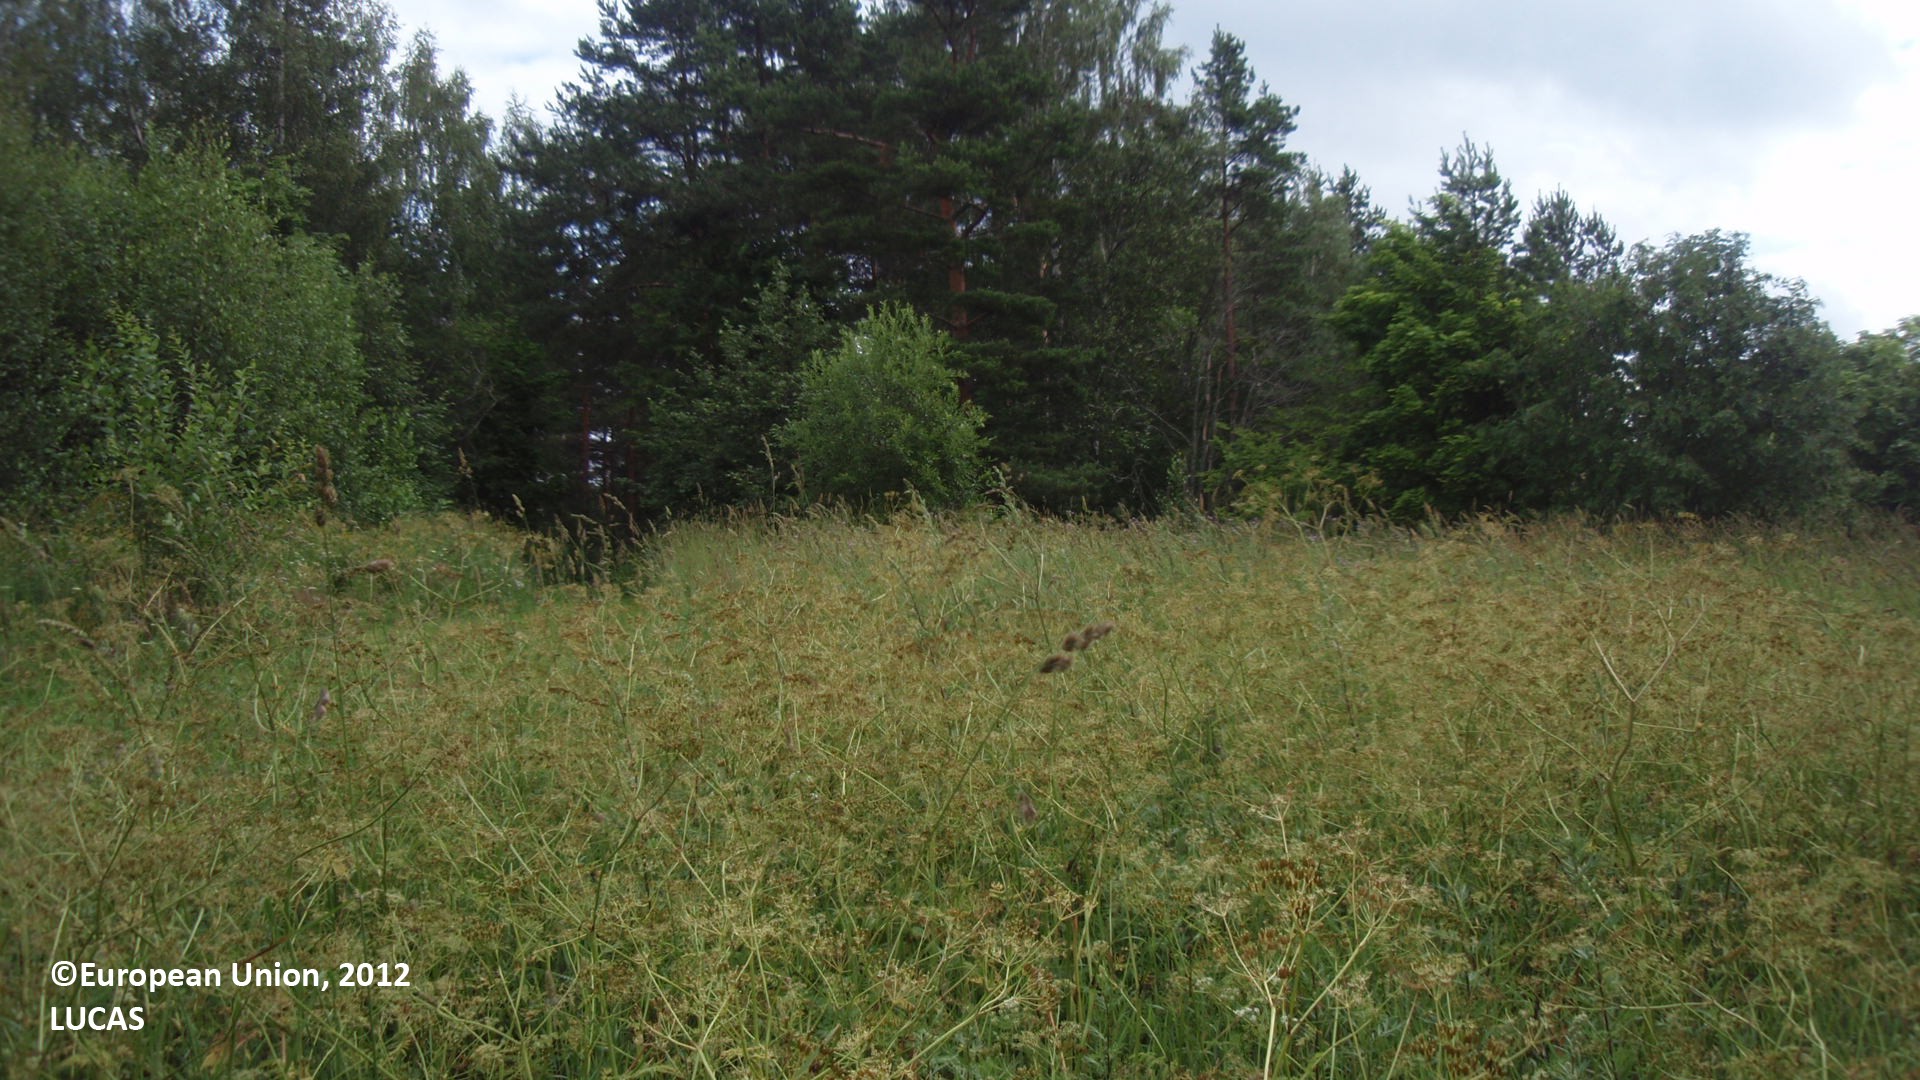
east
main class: Grassland
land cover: Grassland without tree/shrub cover
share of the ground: 50 - 75 %
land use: Fallow land
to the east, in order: Grassland without tree/shrub cover; Broadleaved woodland; Tracks; Grass margins; Paved roads, cycling and walking lanes; Grass margins; Pine dominated mixed woodland; Artificial constructions in urban areas
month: July
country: FI
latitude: 61.0704
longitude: 28.5458
